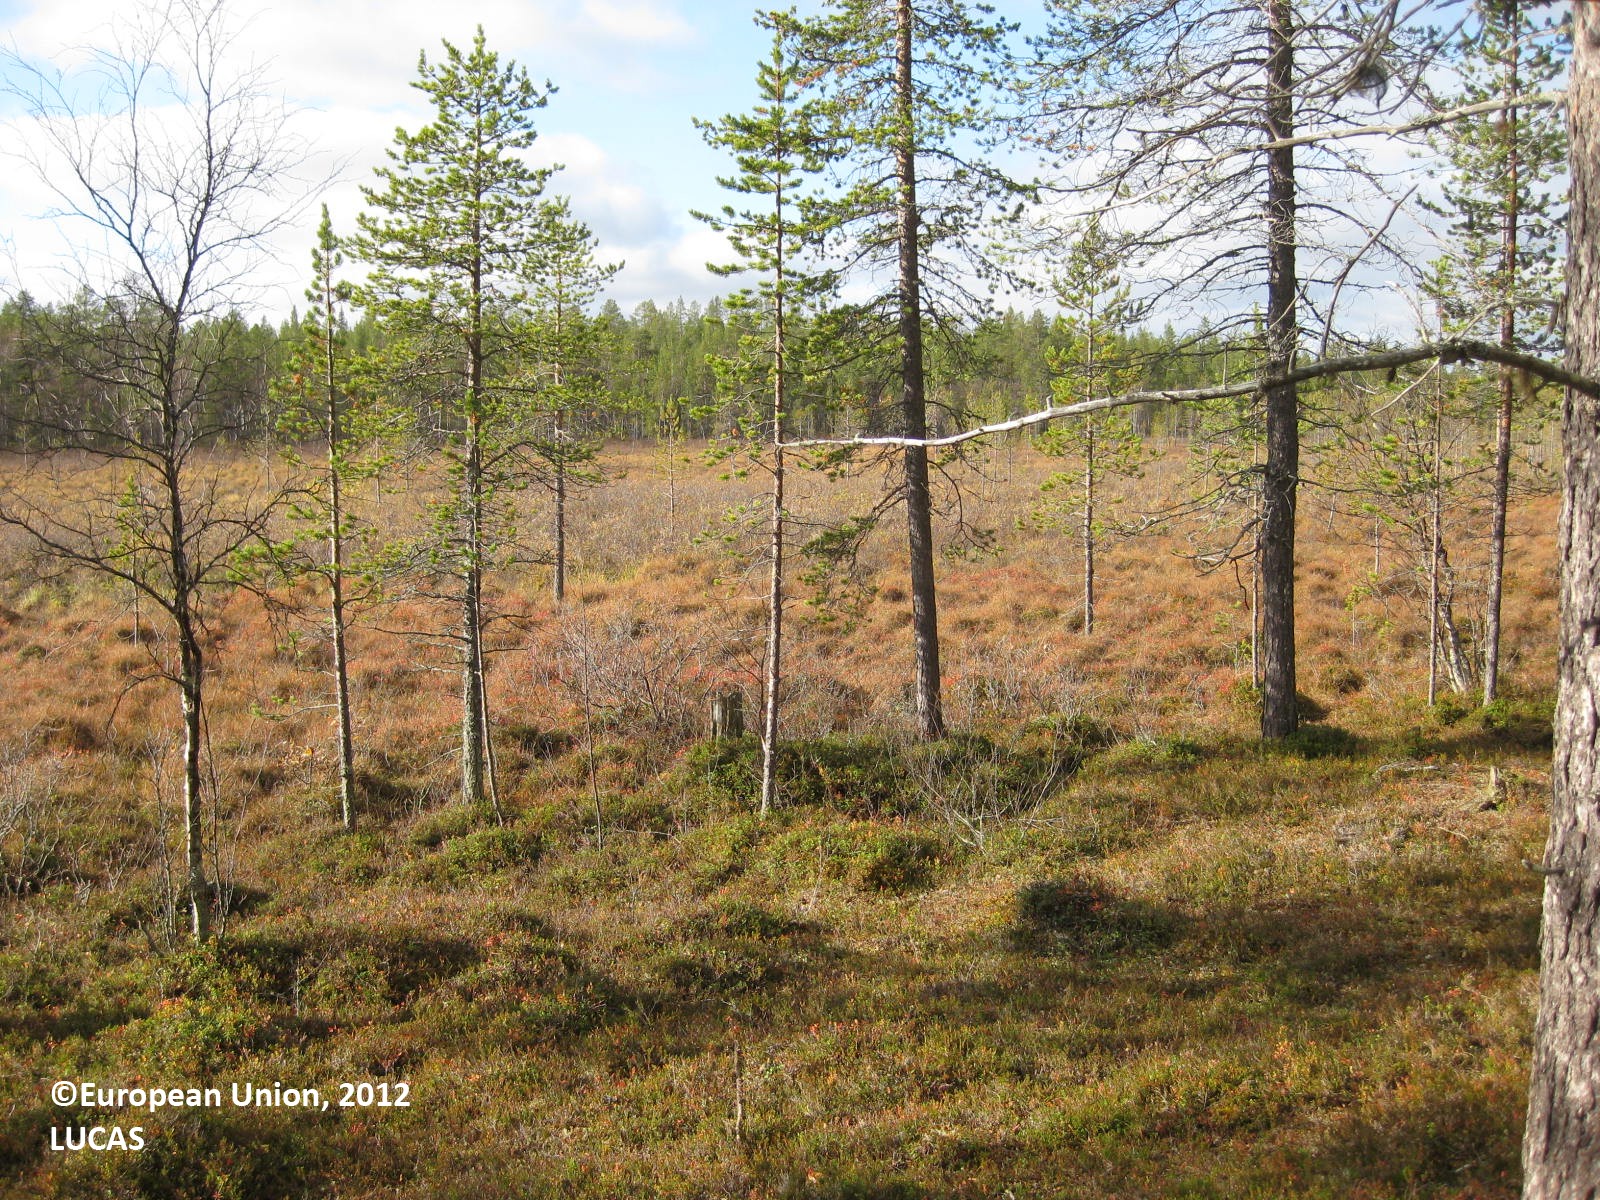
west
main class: Woodland
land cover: Pine dominated coniferous woodland
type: boreal forest
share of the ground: 50 - 75 %
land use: Forestry
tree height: > 5 m
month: September
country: FI
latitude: 68.0544
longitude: 23.7505
